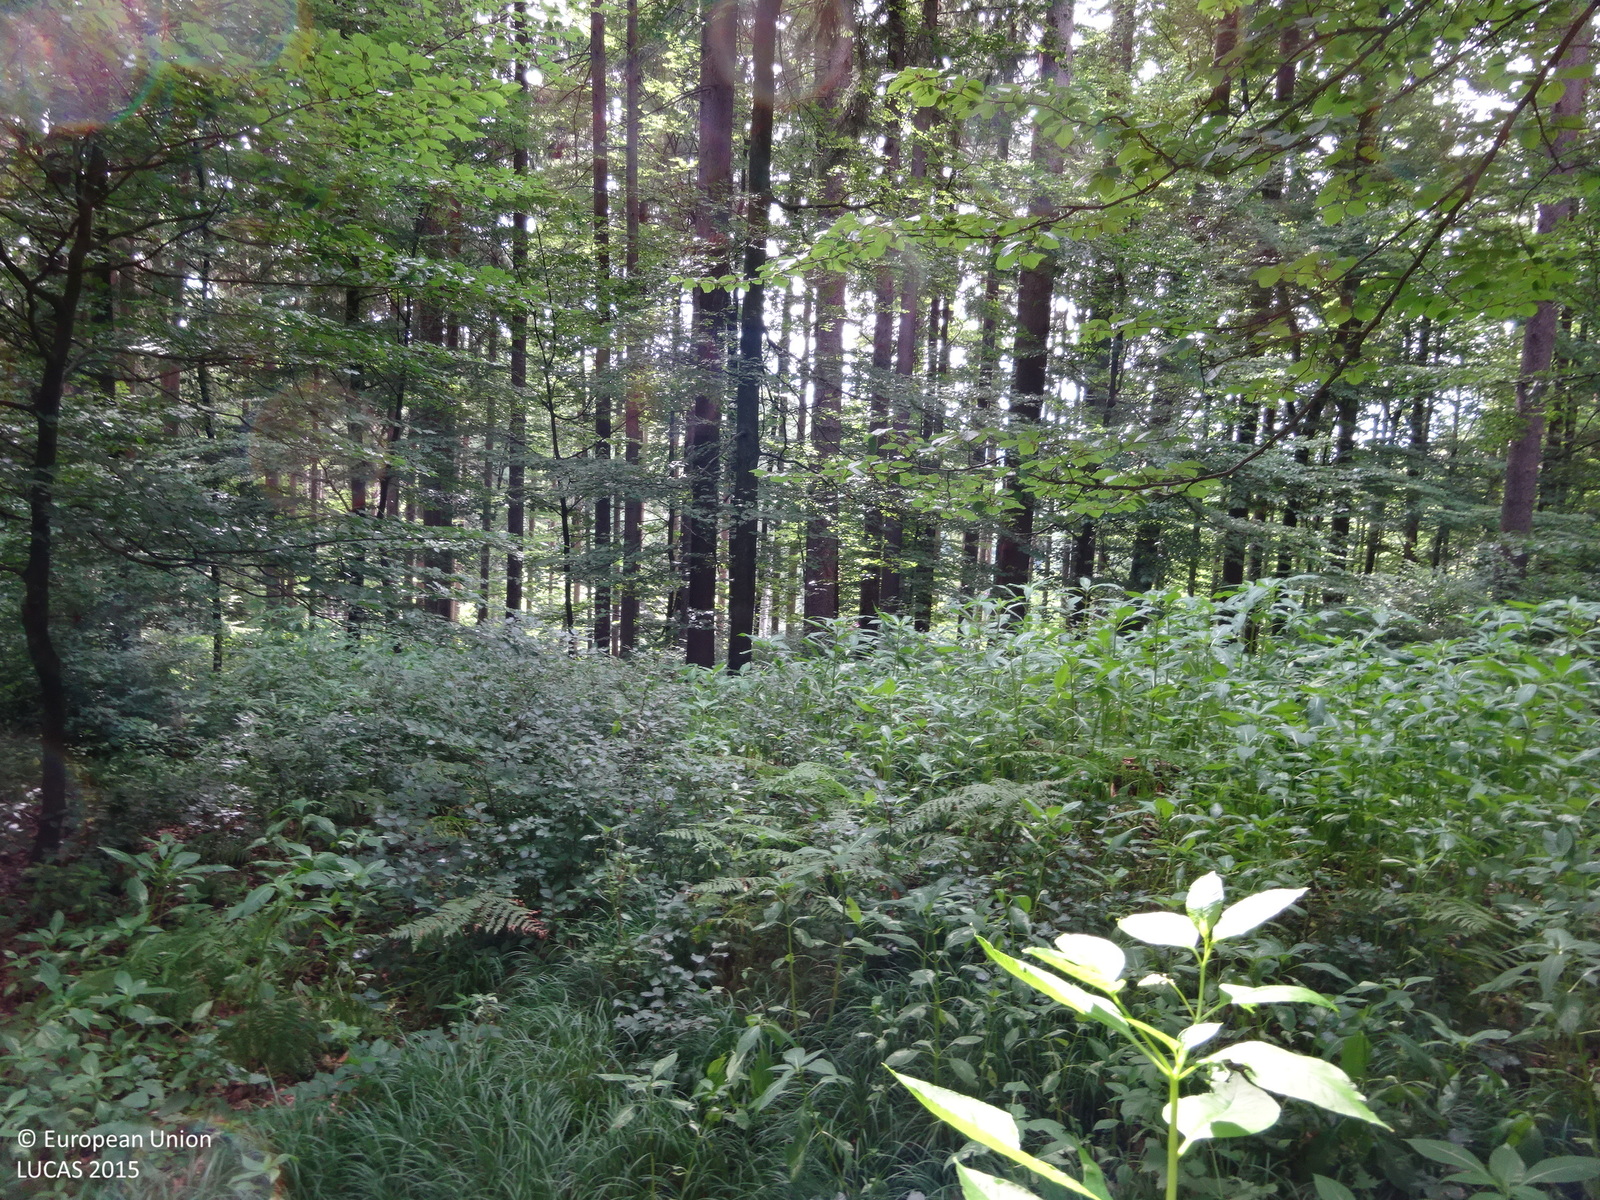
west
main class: Woodland
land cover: Other mixed woodland
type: hemiboreal forest and nemoral coniferous forest and mixed broadleaved-coniferous forest
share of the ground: > 75 %
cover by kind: broadleaved forest trees 65 %, coniferous forest trees 25 %, herbaceous plants 10 %
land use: Forestry
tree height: > 5 m
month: July
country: AT
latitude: 46.9009
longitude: 15.3946
